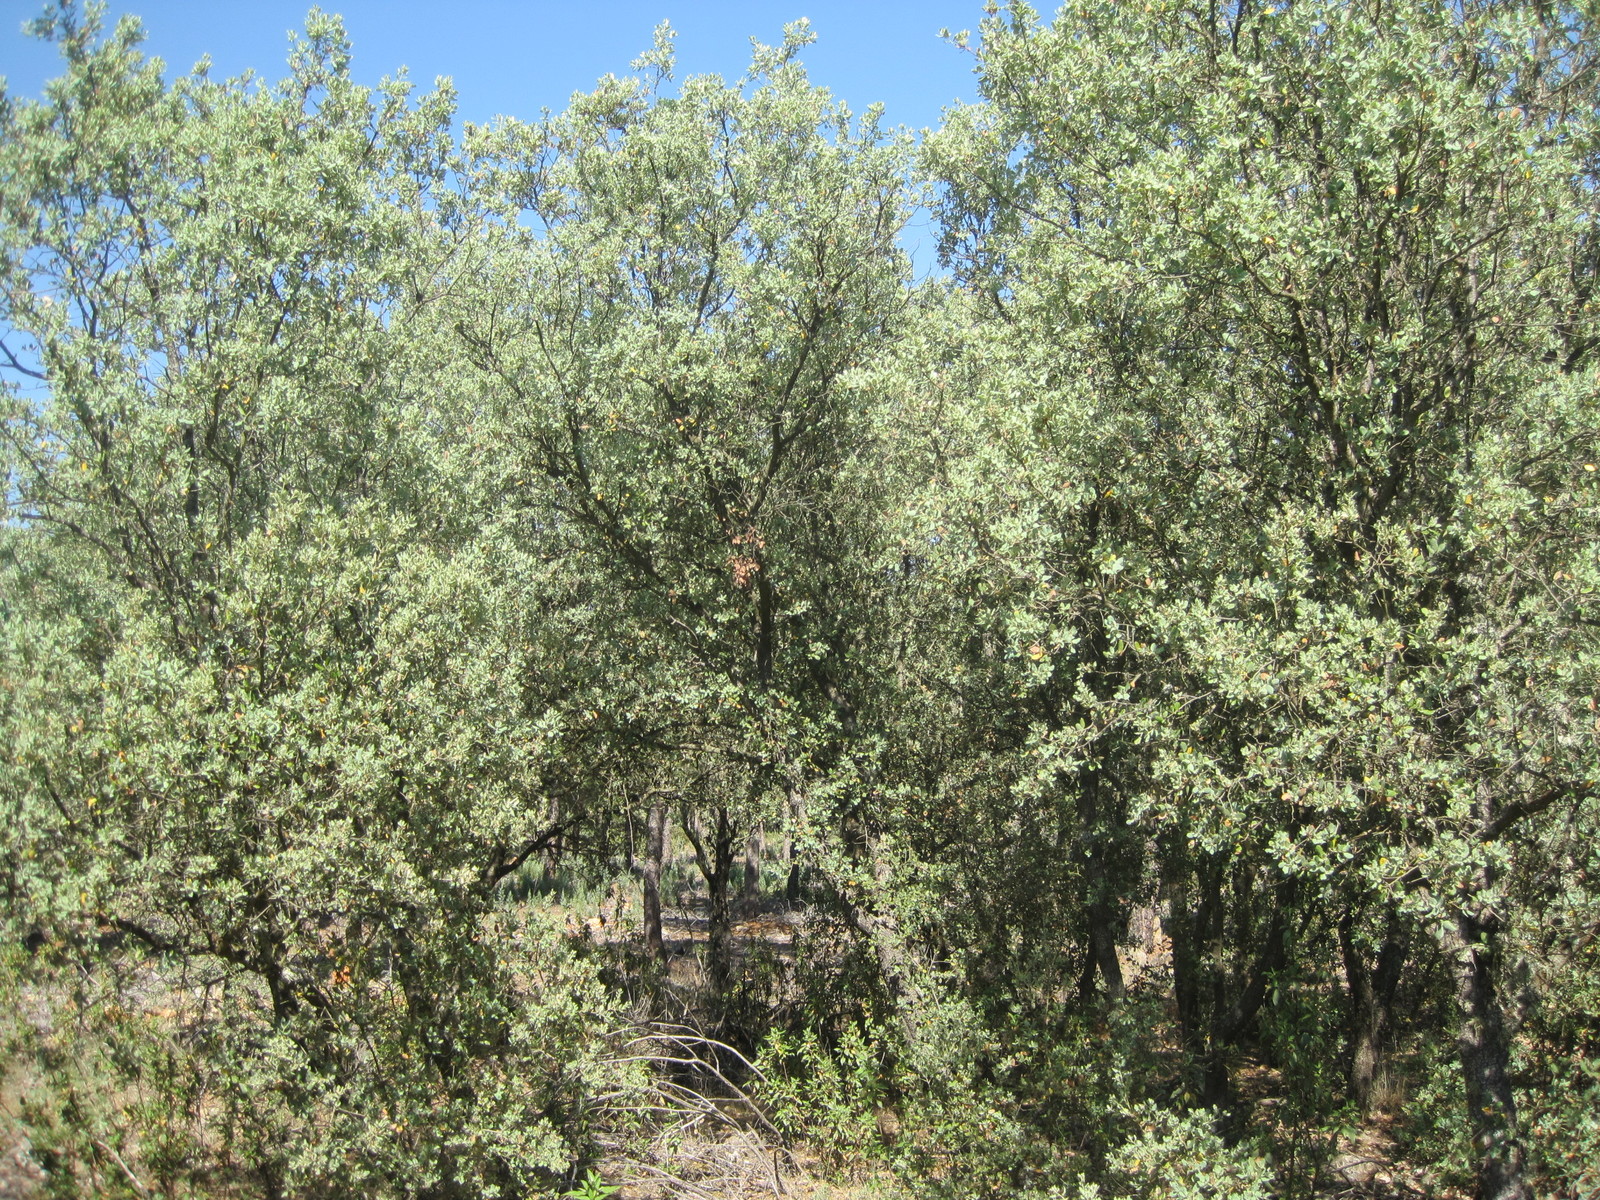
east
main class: Woodland
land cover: Pine dominated mixed woodland
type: coniferous forest of the mediterranean region
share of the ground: > 75 %
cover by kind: coniferous forest trees 50 %, broadleaved forest trees 30 %, herbaceous plants 20 %
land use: Forestry
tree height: > 5 m
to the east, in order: Pine dominated mixed woodland
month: July
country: ES
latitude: 41.8843
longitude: -4.7138
